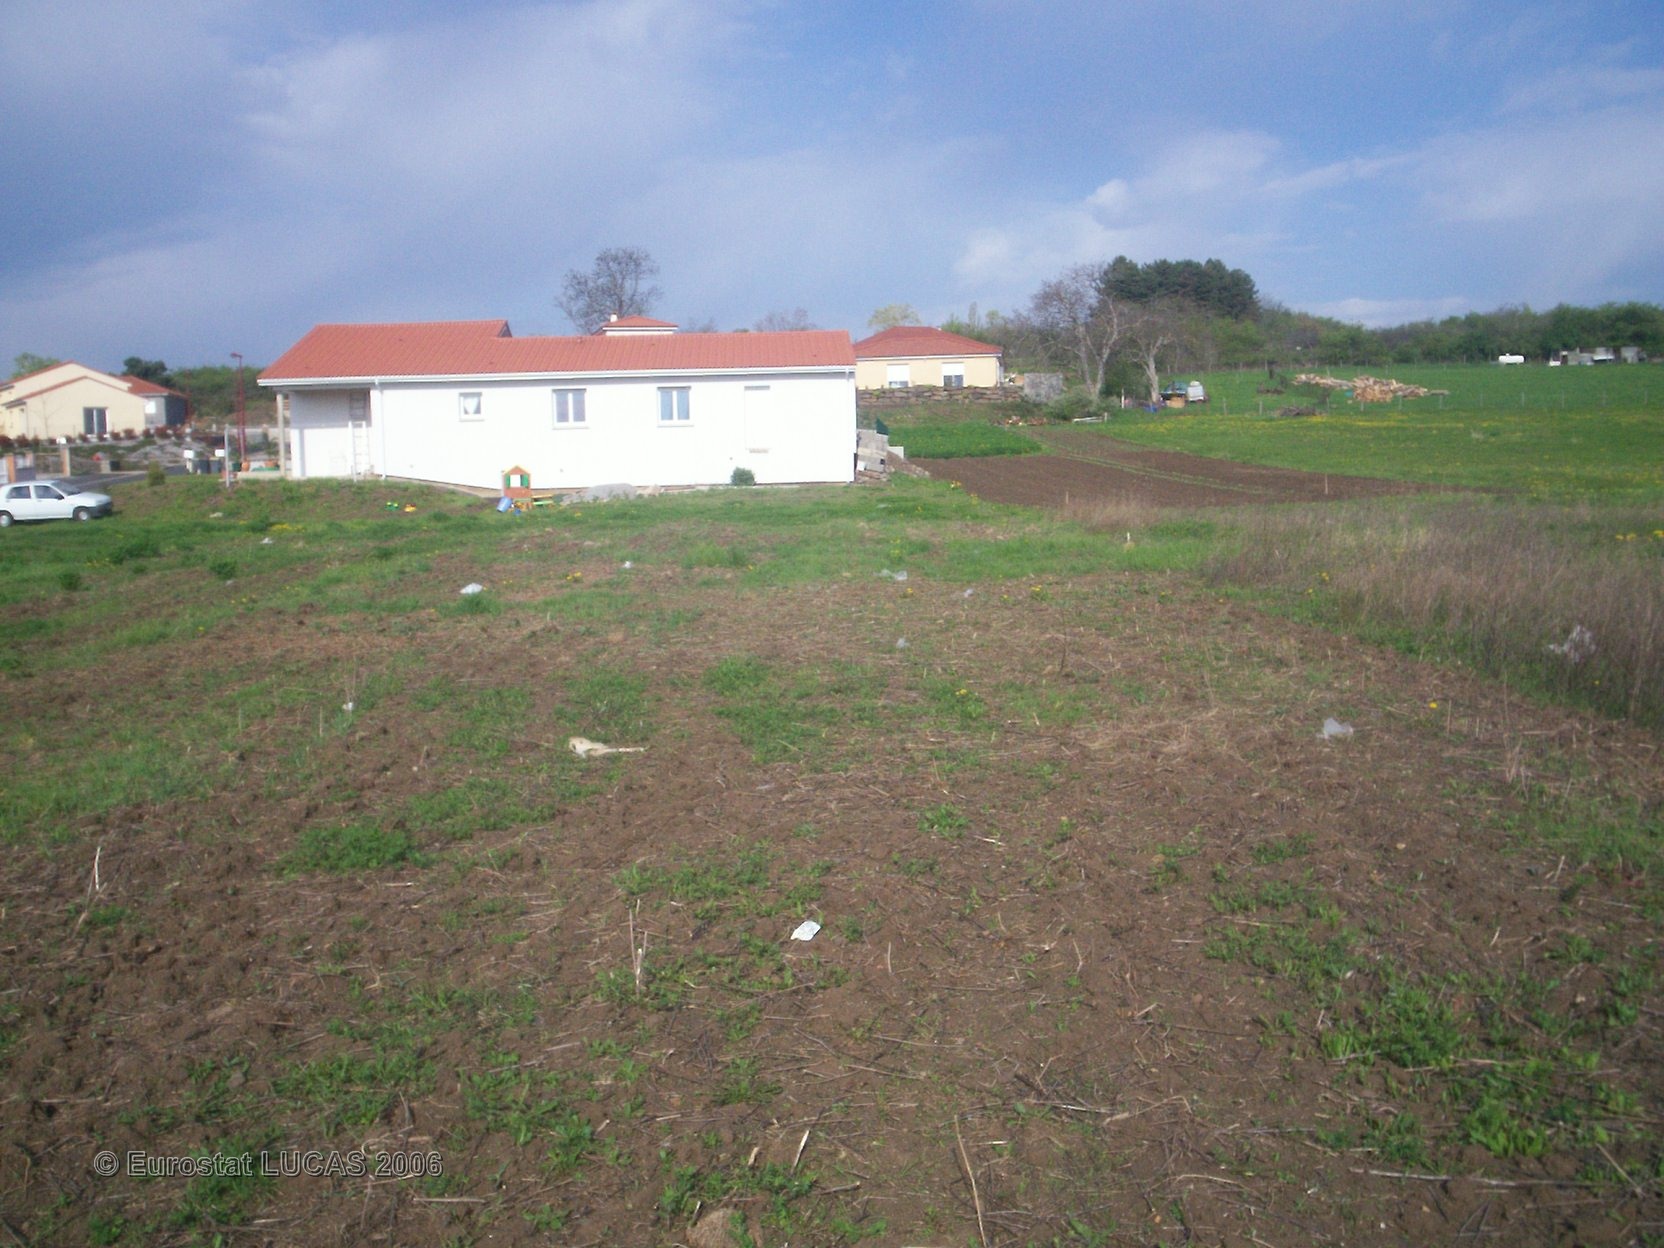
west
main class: Grassland
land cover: Grassland without tree/shrub cover
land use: Fallow land
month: April
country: FR
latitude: 45.8561
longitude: 3.0834
